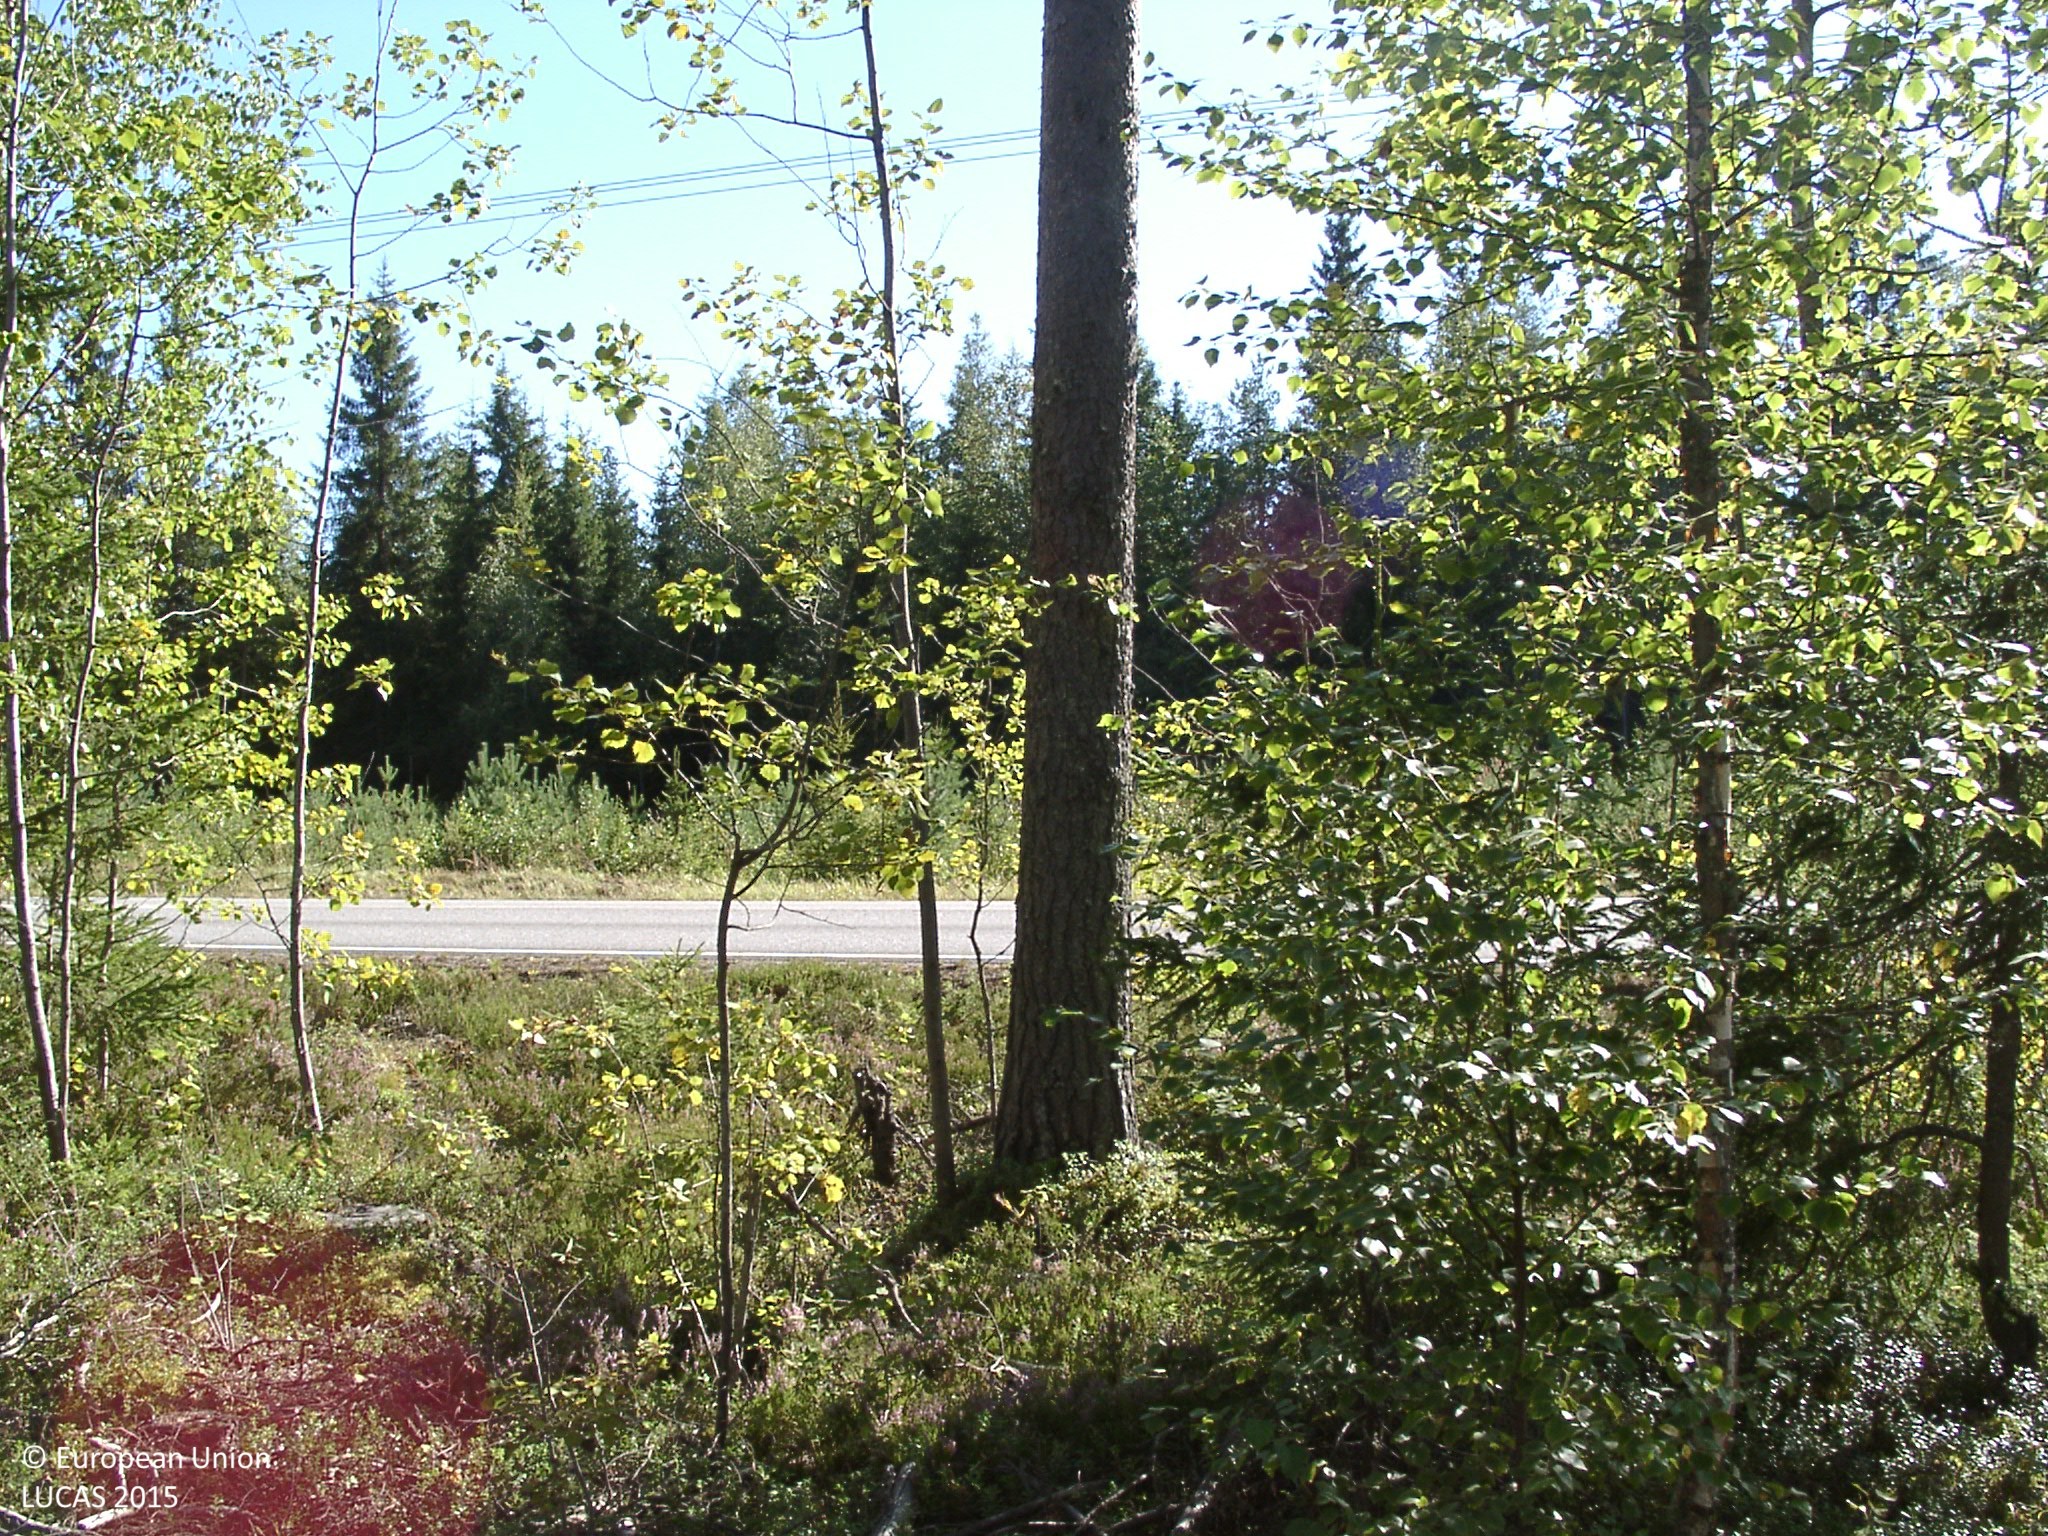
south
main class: Woodland
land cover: Pine dominated coniferous woodland
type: boreal forest
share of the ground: 50 - 75 %
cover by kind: coniferous forest trees 45 %, shrubs 30 %, broadleaved forest trees 10 %, lichens and mosses 10 %
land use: Forestry
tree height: > 5 m
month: August
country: FI
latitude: 61.8873
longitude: 25.0404
